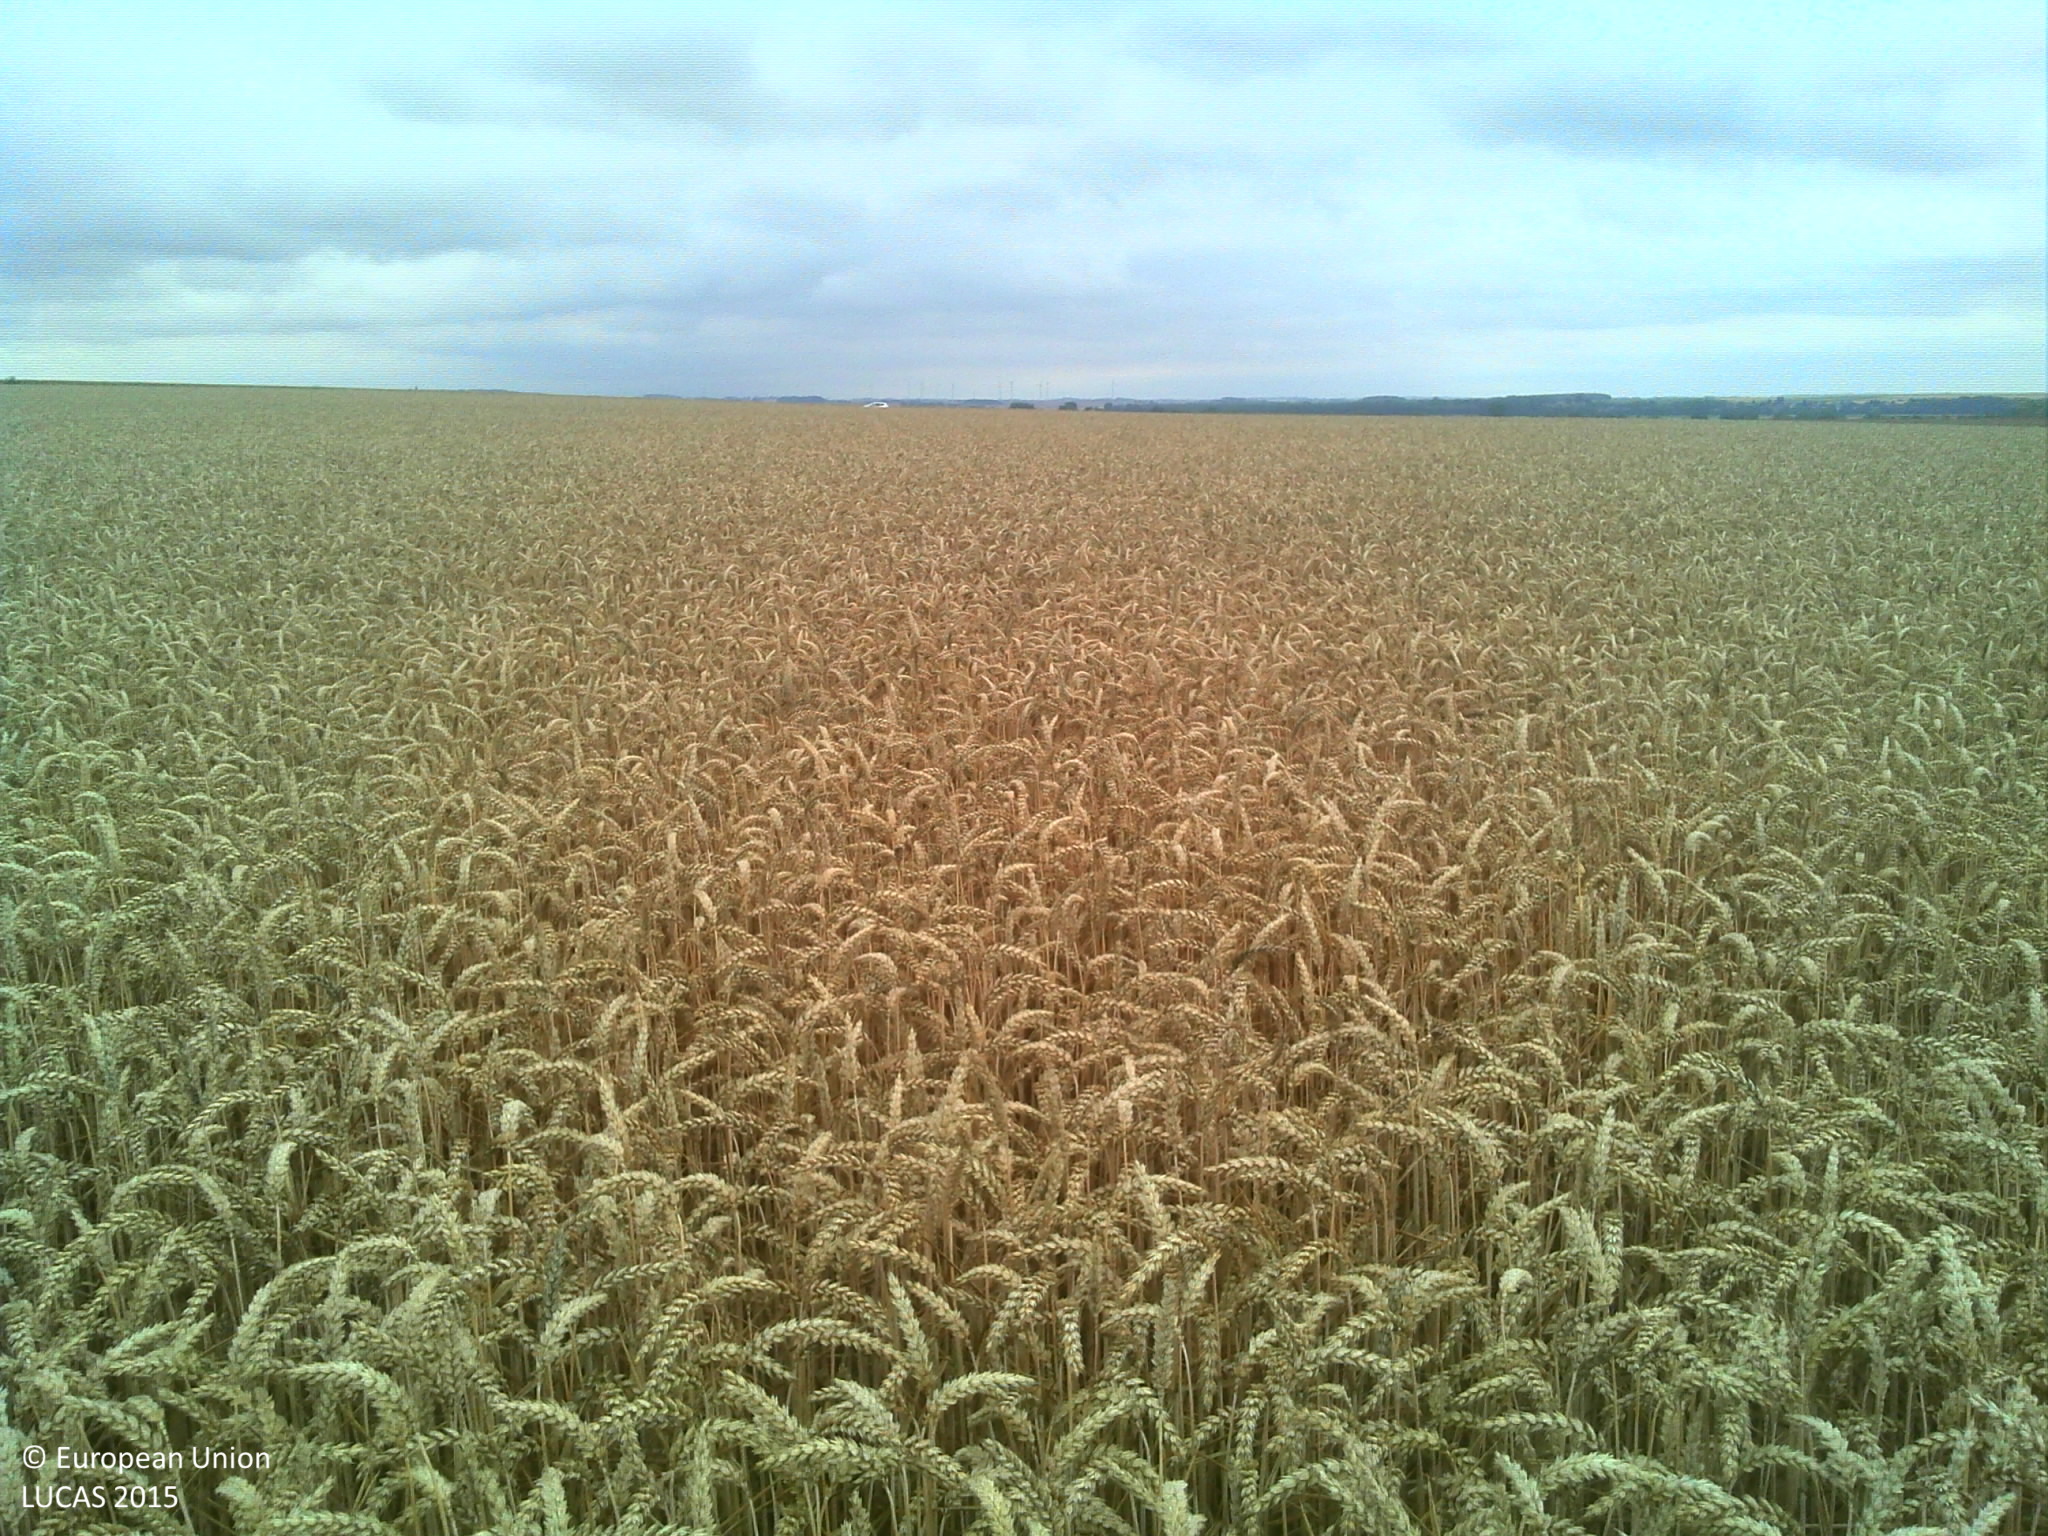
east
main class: Cropland
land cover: Common wheat
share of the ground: > 75 %
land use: Agriculture (excluding fallow land and kitchen gardens)
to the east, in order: Common wheat
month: July
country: FR
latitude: 49.7010
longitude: 3.6570
